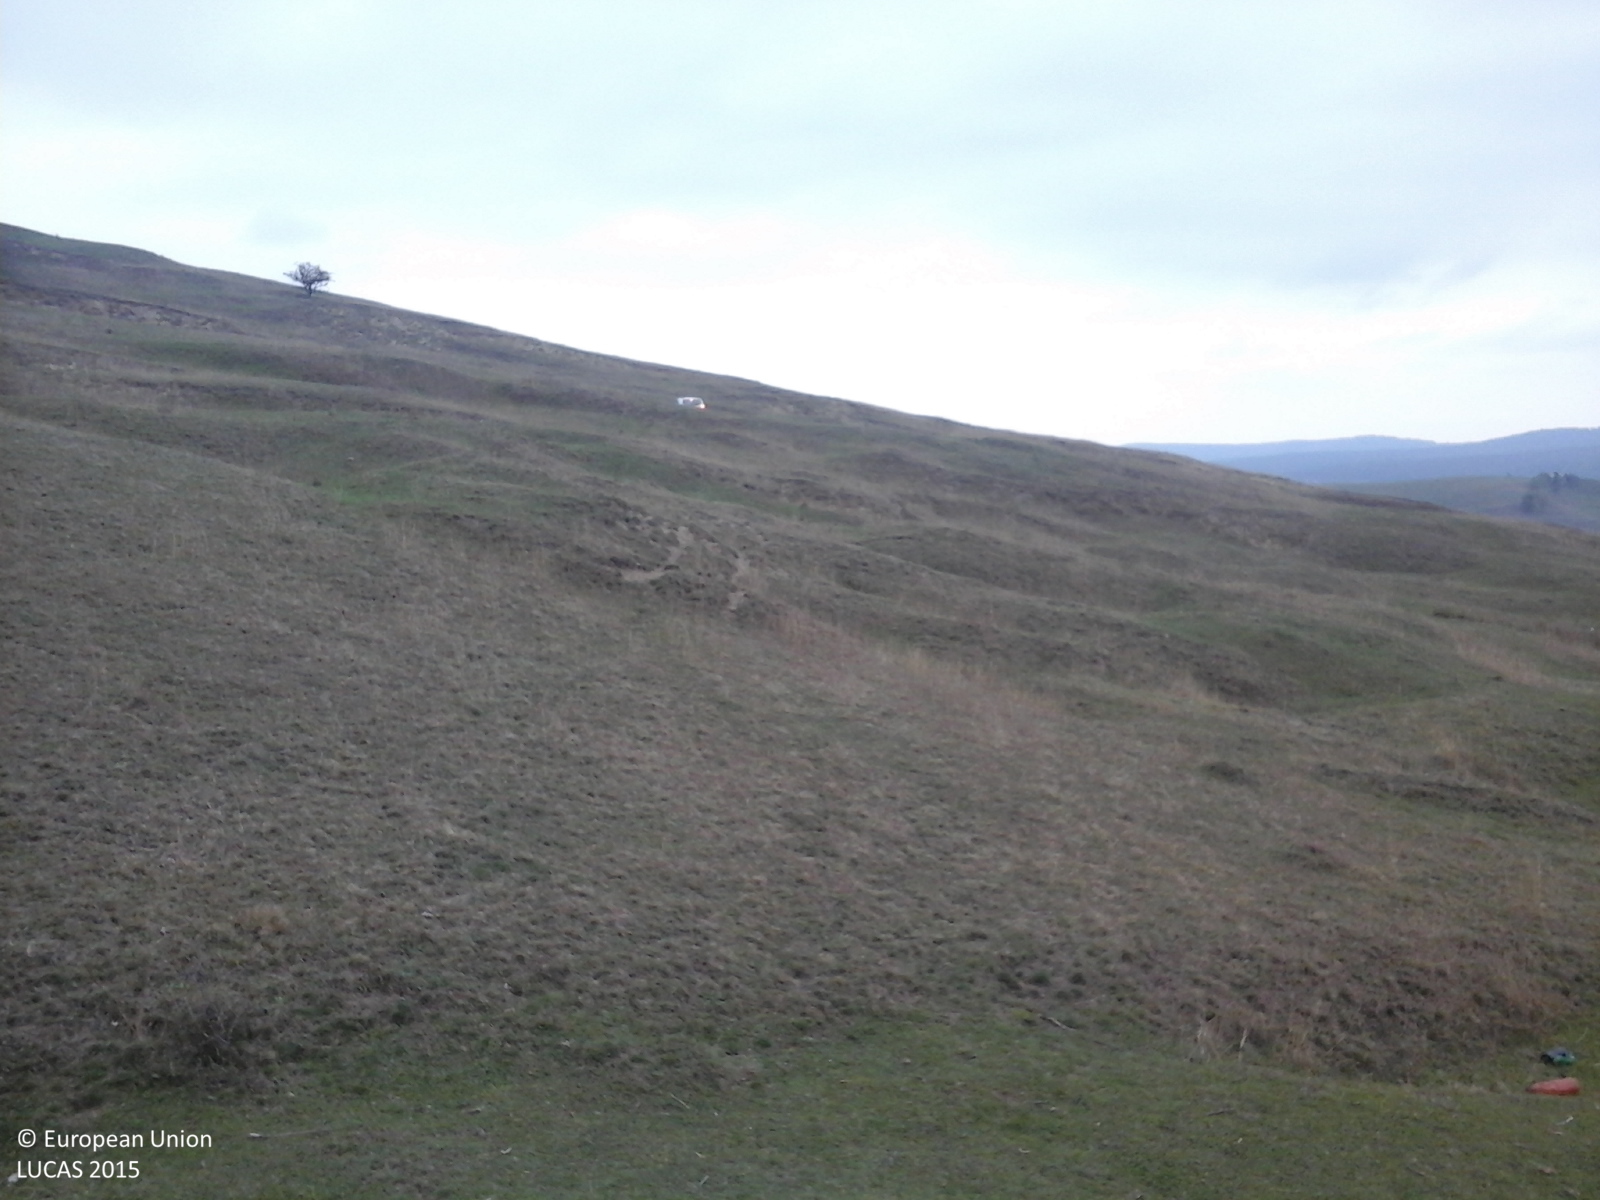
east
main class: Grassland
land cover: Grassland without tree/shrub cover
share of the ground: > 75 %
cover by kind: herbaceous plants 100 %
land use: Agriculture (excluding fallow land and kitchen gardens)
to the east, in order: Grassland without tree/shrub cover
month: October
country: RO
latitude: 46.0196
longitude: 25.1189
